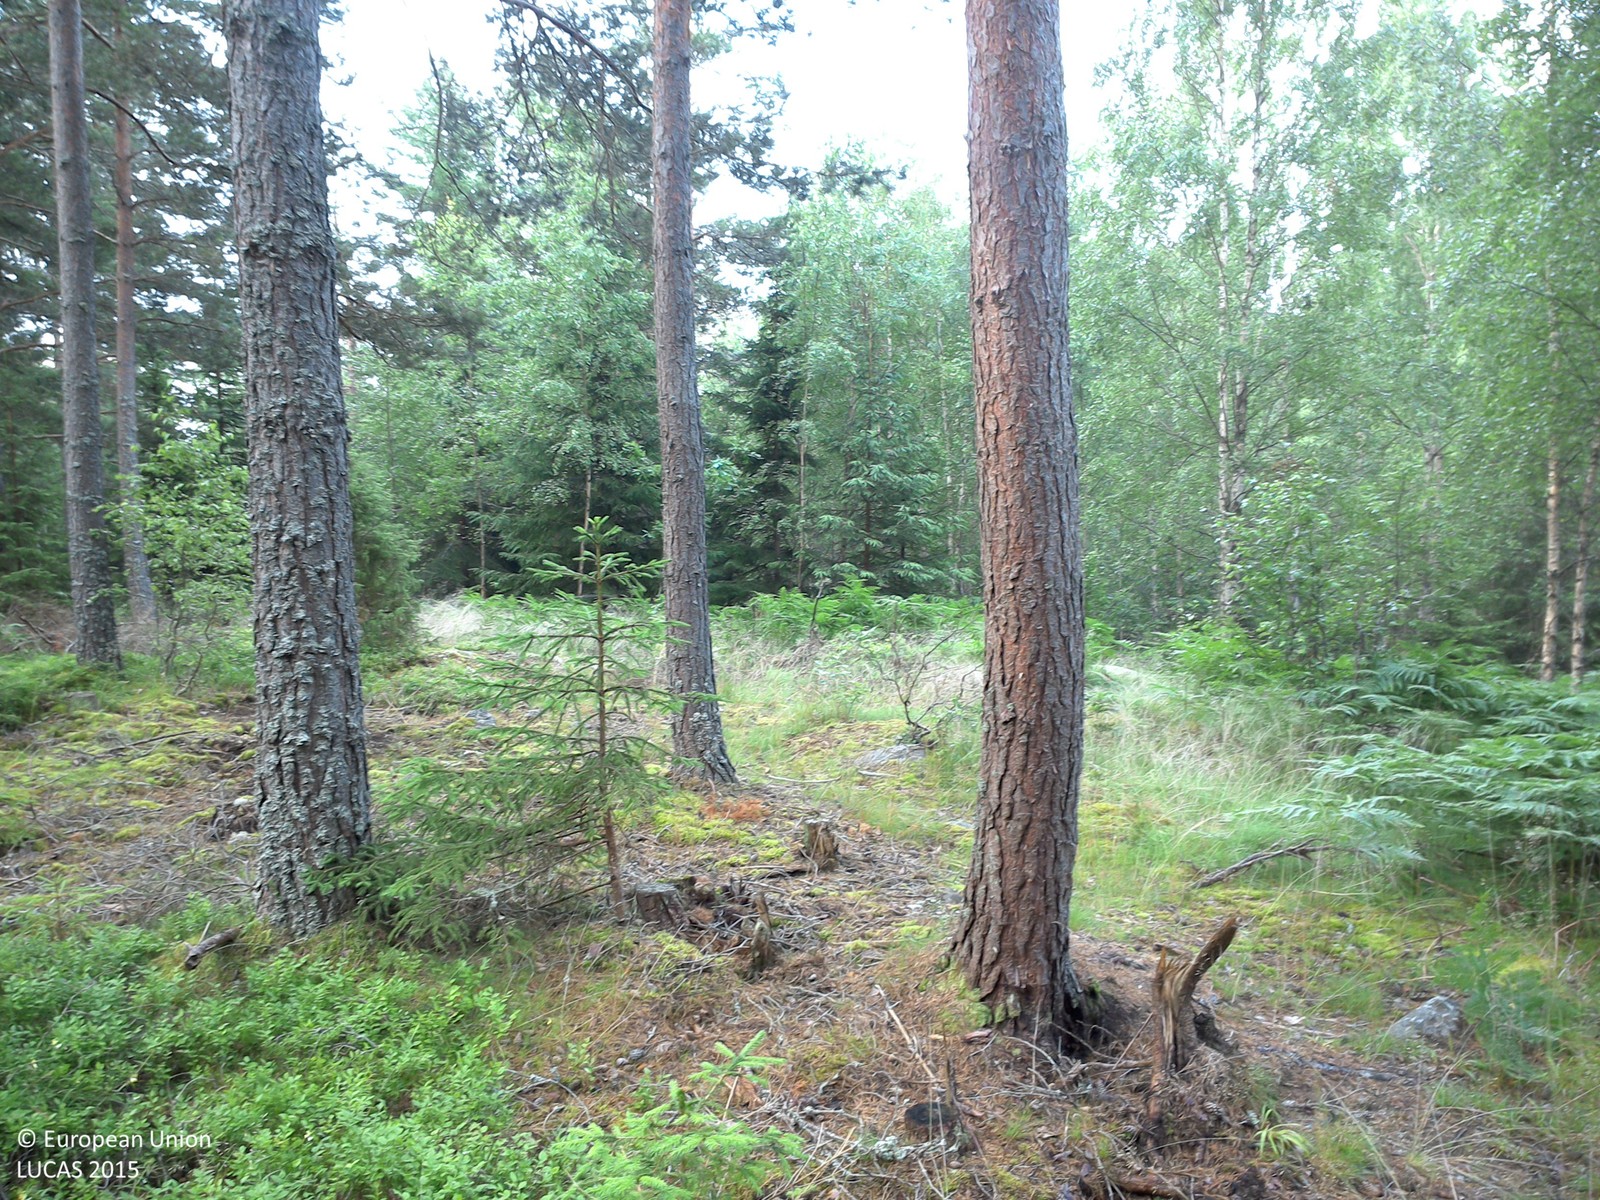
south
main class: Woodland
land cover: Pine dominated coniferous woodland
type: boreal forest
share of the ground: 25 - 50 %
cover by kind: coniferous forest trees 45 %, herbaceous plants 35 %, lichens and mosses 20 %
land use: Forestry
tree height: > 5 m
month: July
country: SE
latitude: 58.2711
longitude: 14.9894
